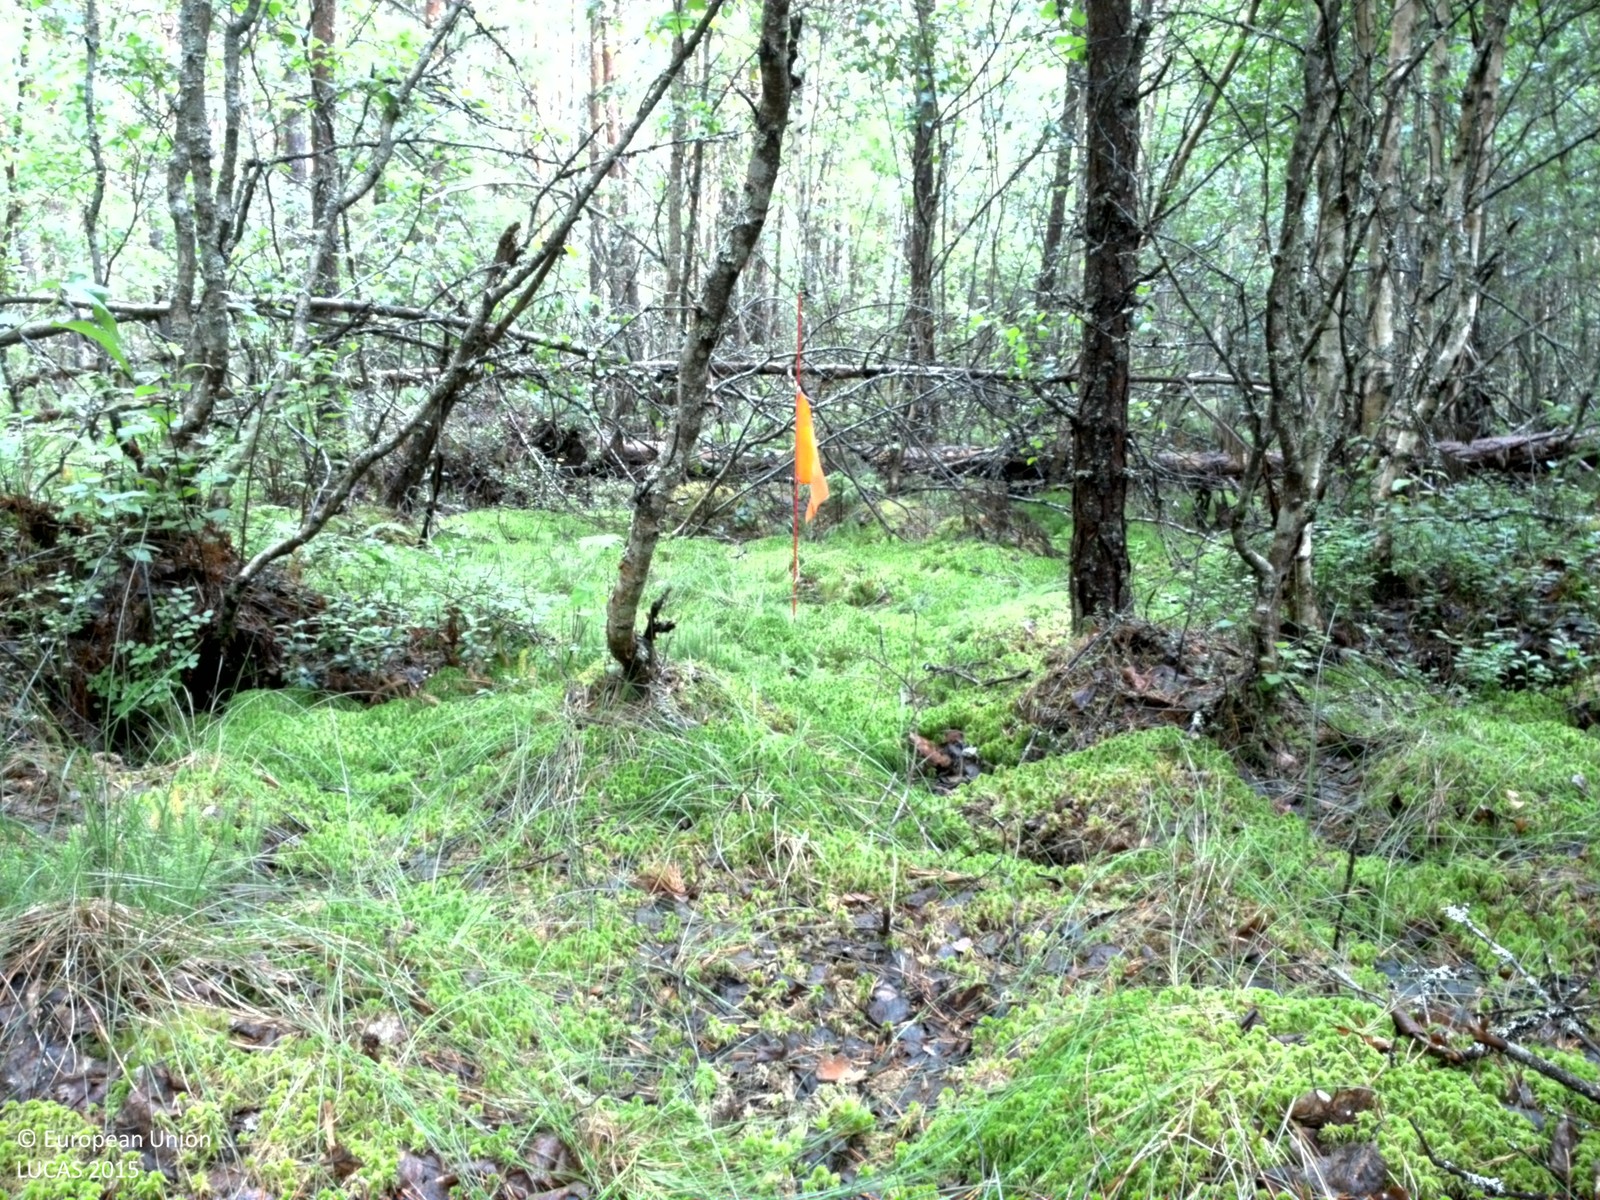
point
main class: Woodland
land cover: Pine dominated mixed woodland
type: boreal forest
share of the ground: > 75 %
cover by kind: coniferous forest trees 55 %, broadleaved forest trees 25 %, lichens and mosses 20 %
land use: Forestry
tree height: > 5 m
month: July
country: SE
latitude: 60.0192
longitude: 17.1143
